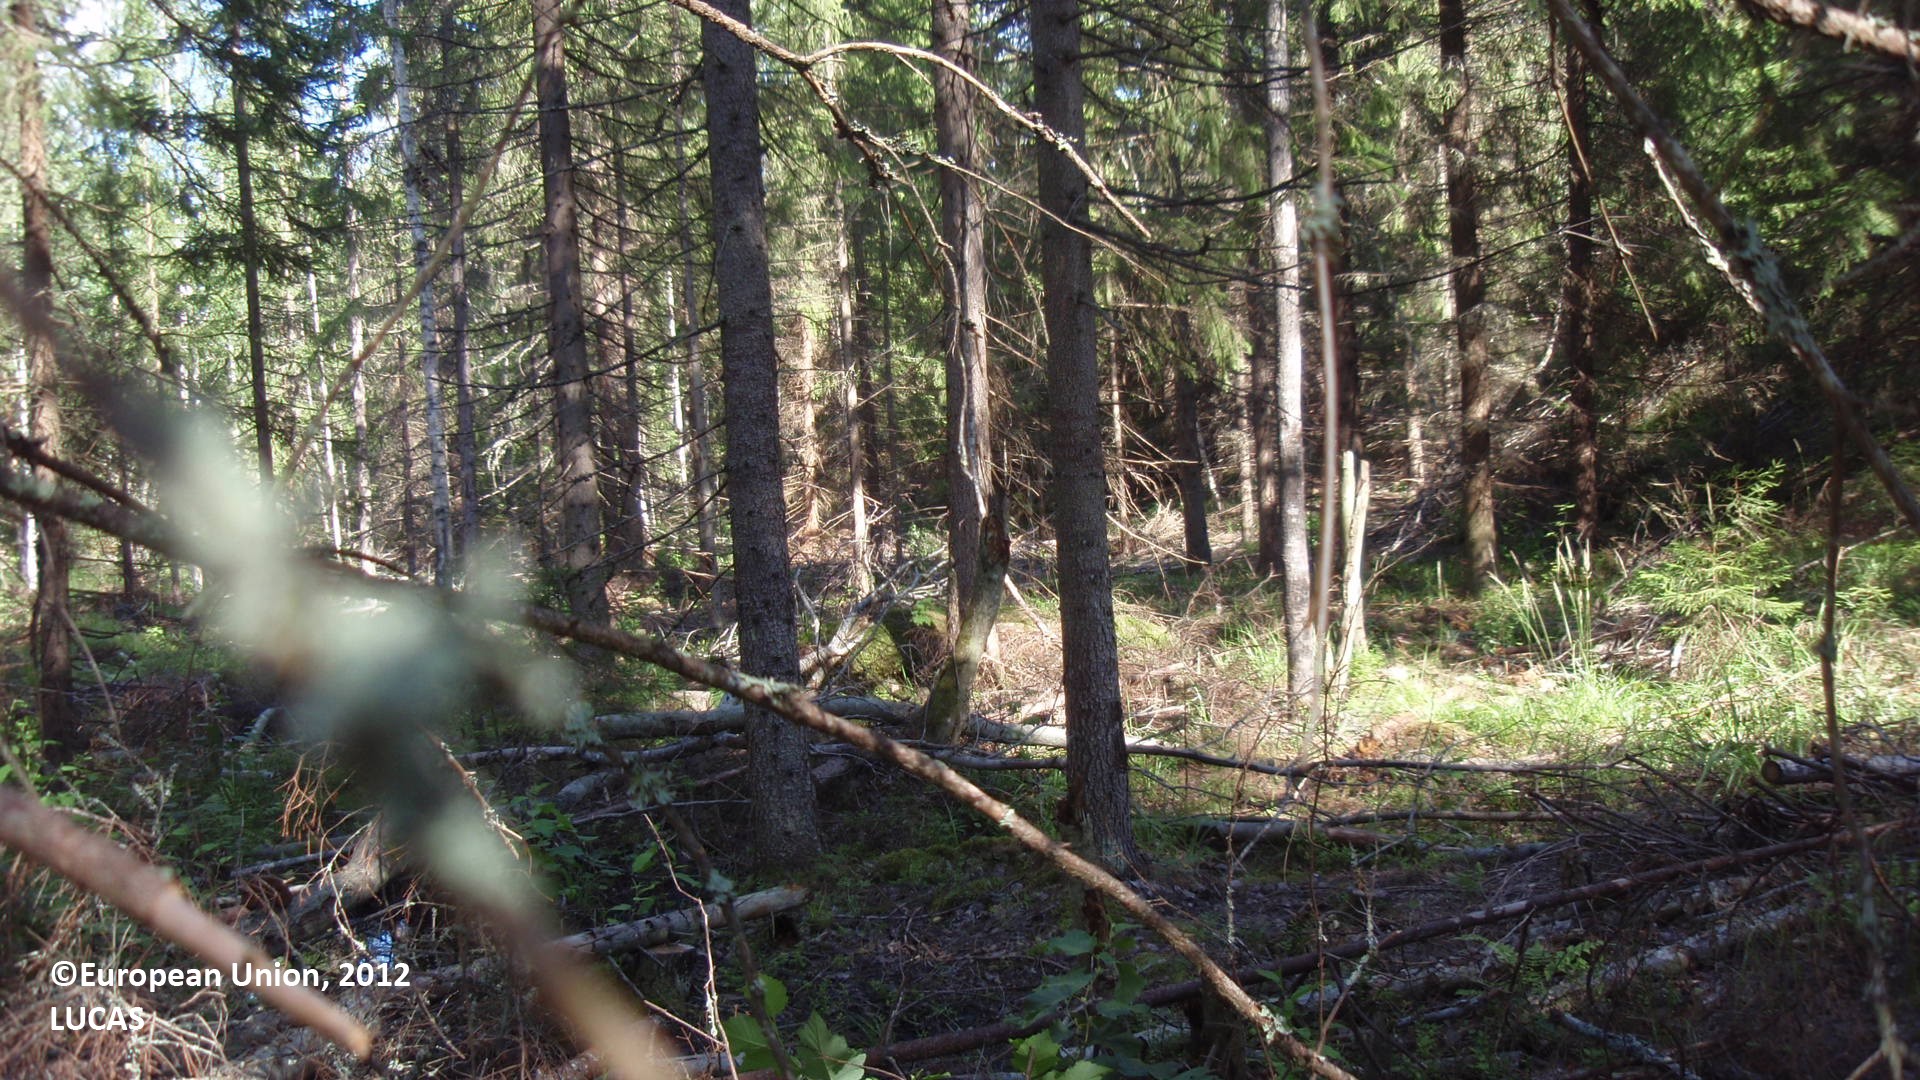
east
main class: Woodland
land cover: Spruce dominated mixed woodland
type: boreal forest
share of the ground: 25 - 50 %
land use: Forestry
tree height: > 5 m
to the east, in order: Spruce dominated mixed woodland; Inland water bodies
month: July
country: FI
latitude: 61.1121
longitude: 28.2239
